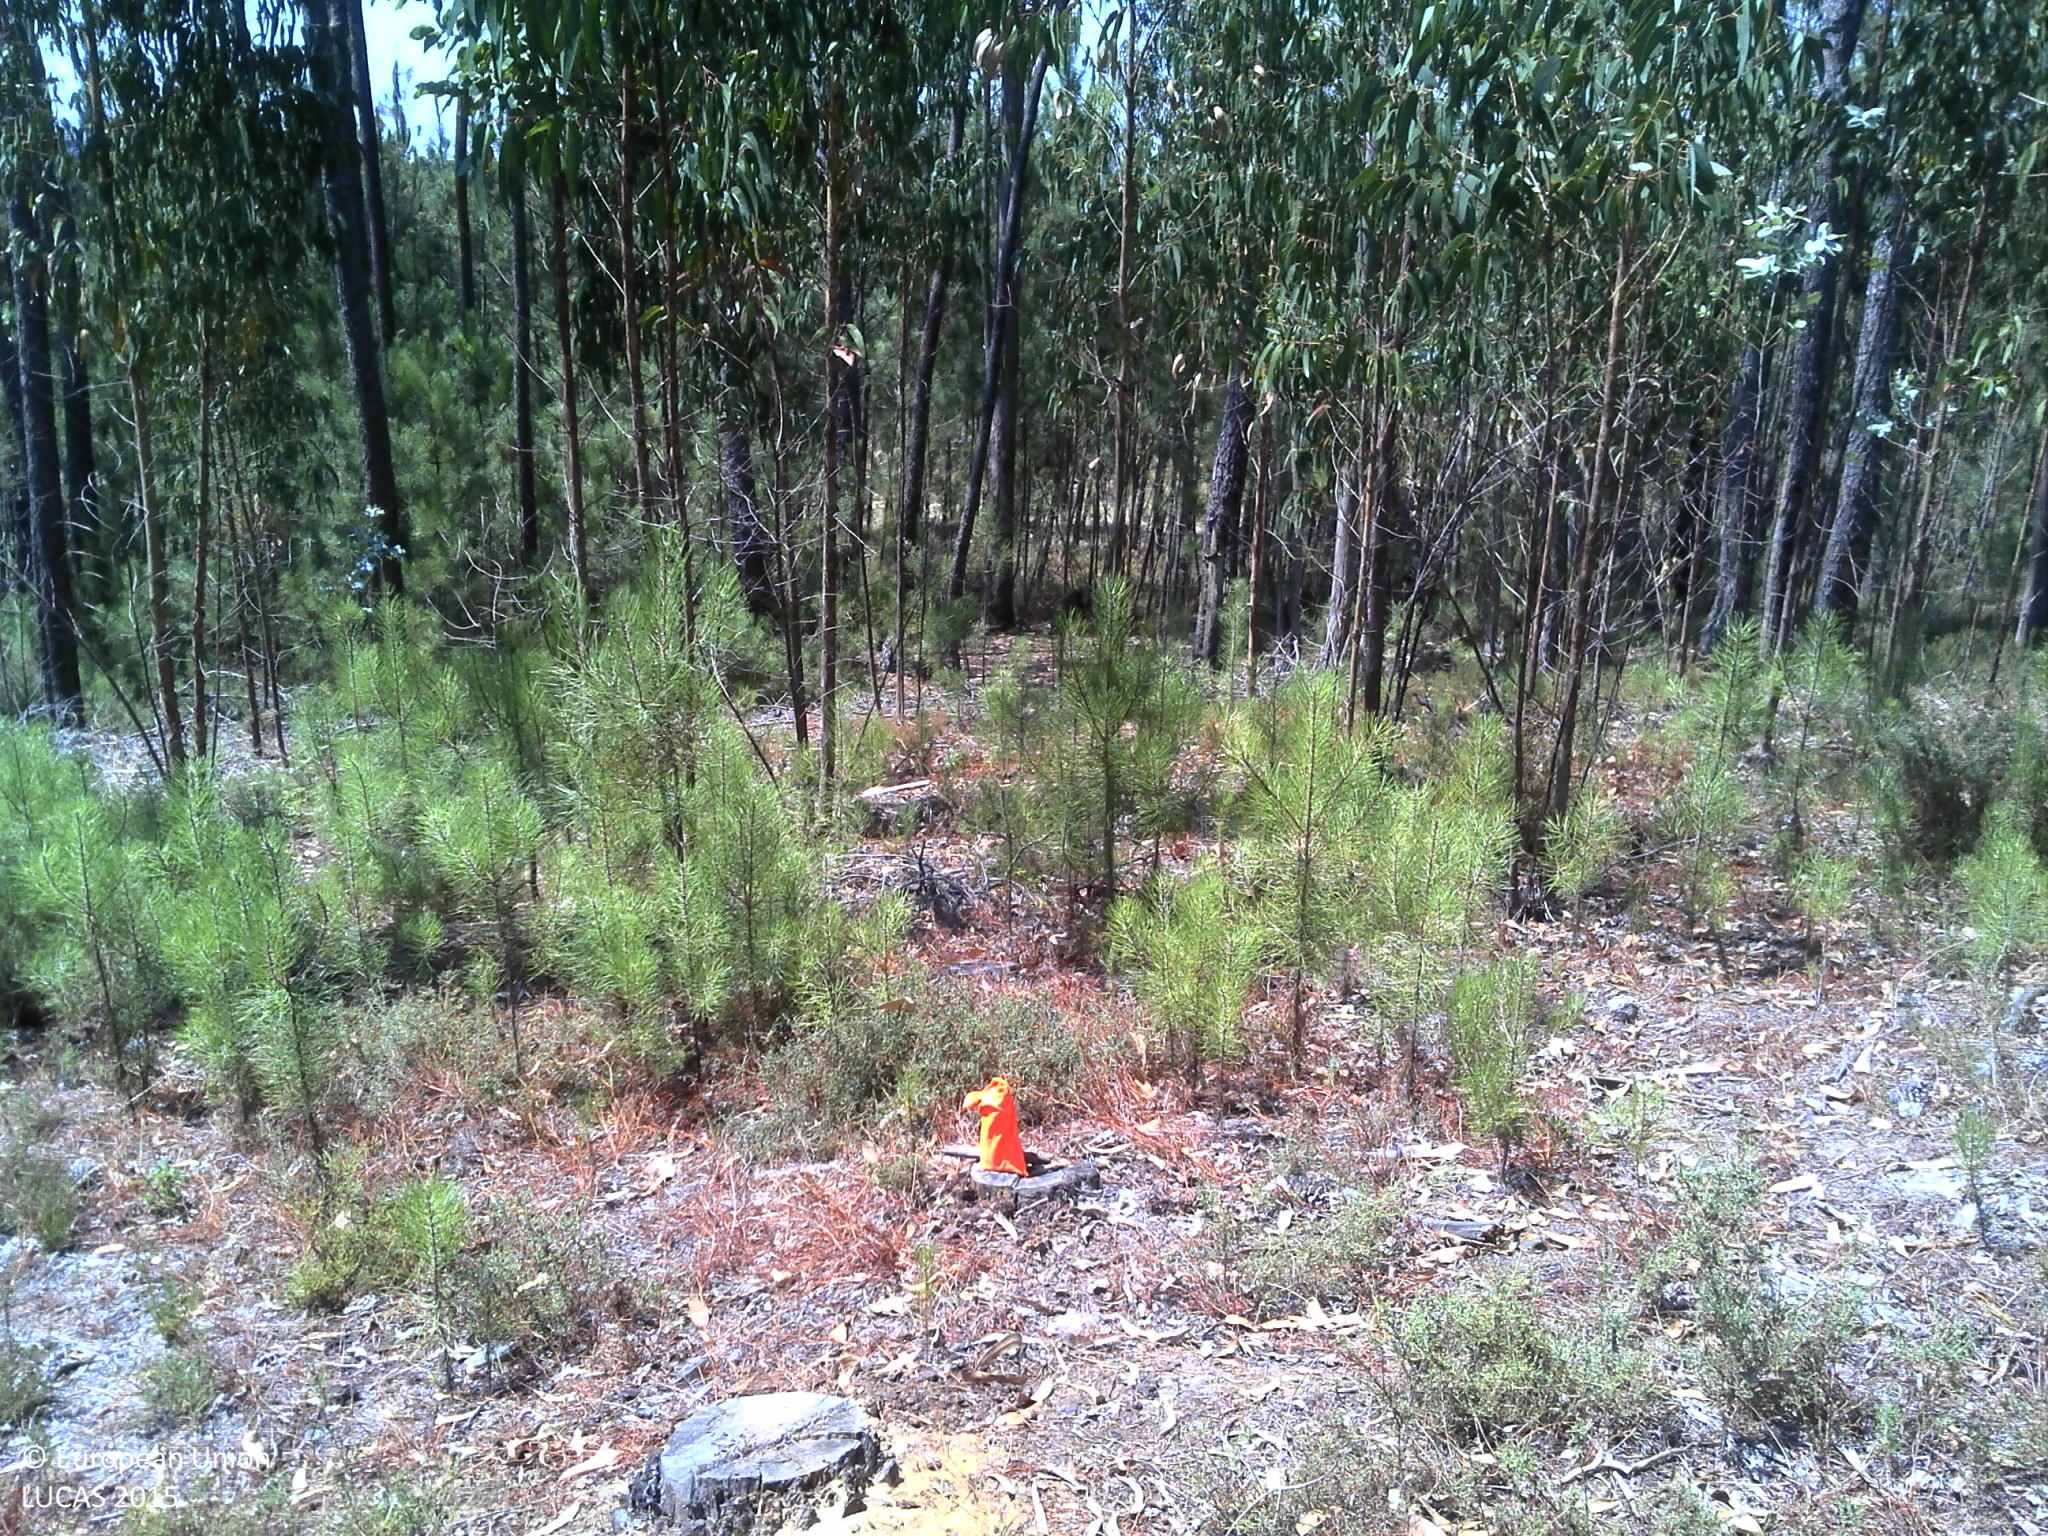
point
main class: Woodland
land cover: Pine dominated mixed woodland
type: coniferous forest of the mediterranean region
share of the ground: 10 - 25 %
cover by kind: shrubs 30 %, unconsolidated bare surface 30 %, coniferous forest trees 20 %, broadleaved forest trees 20 %
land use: Forestry
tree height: > 5 m
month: July
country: PT
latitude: 40.0715
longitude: -8.5523
